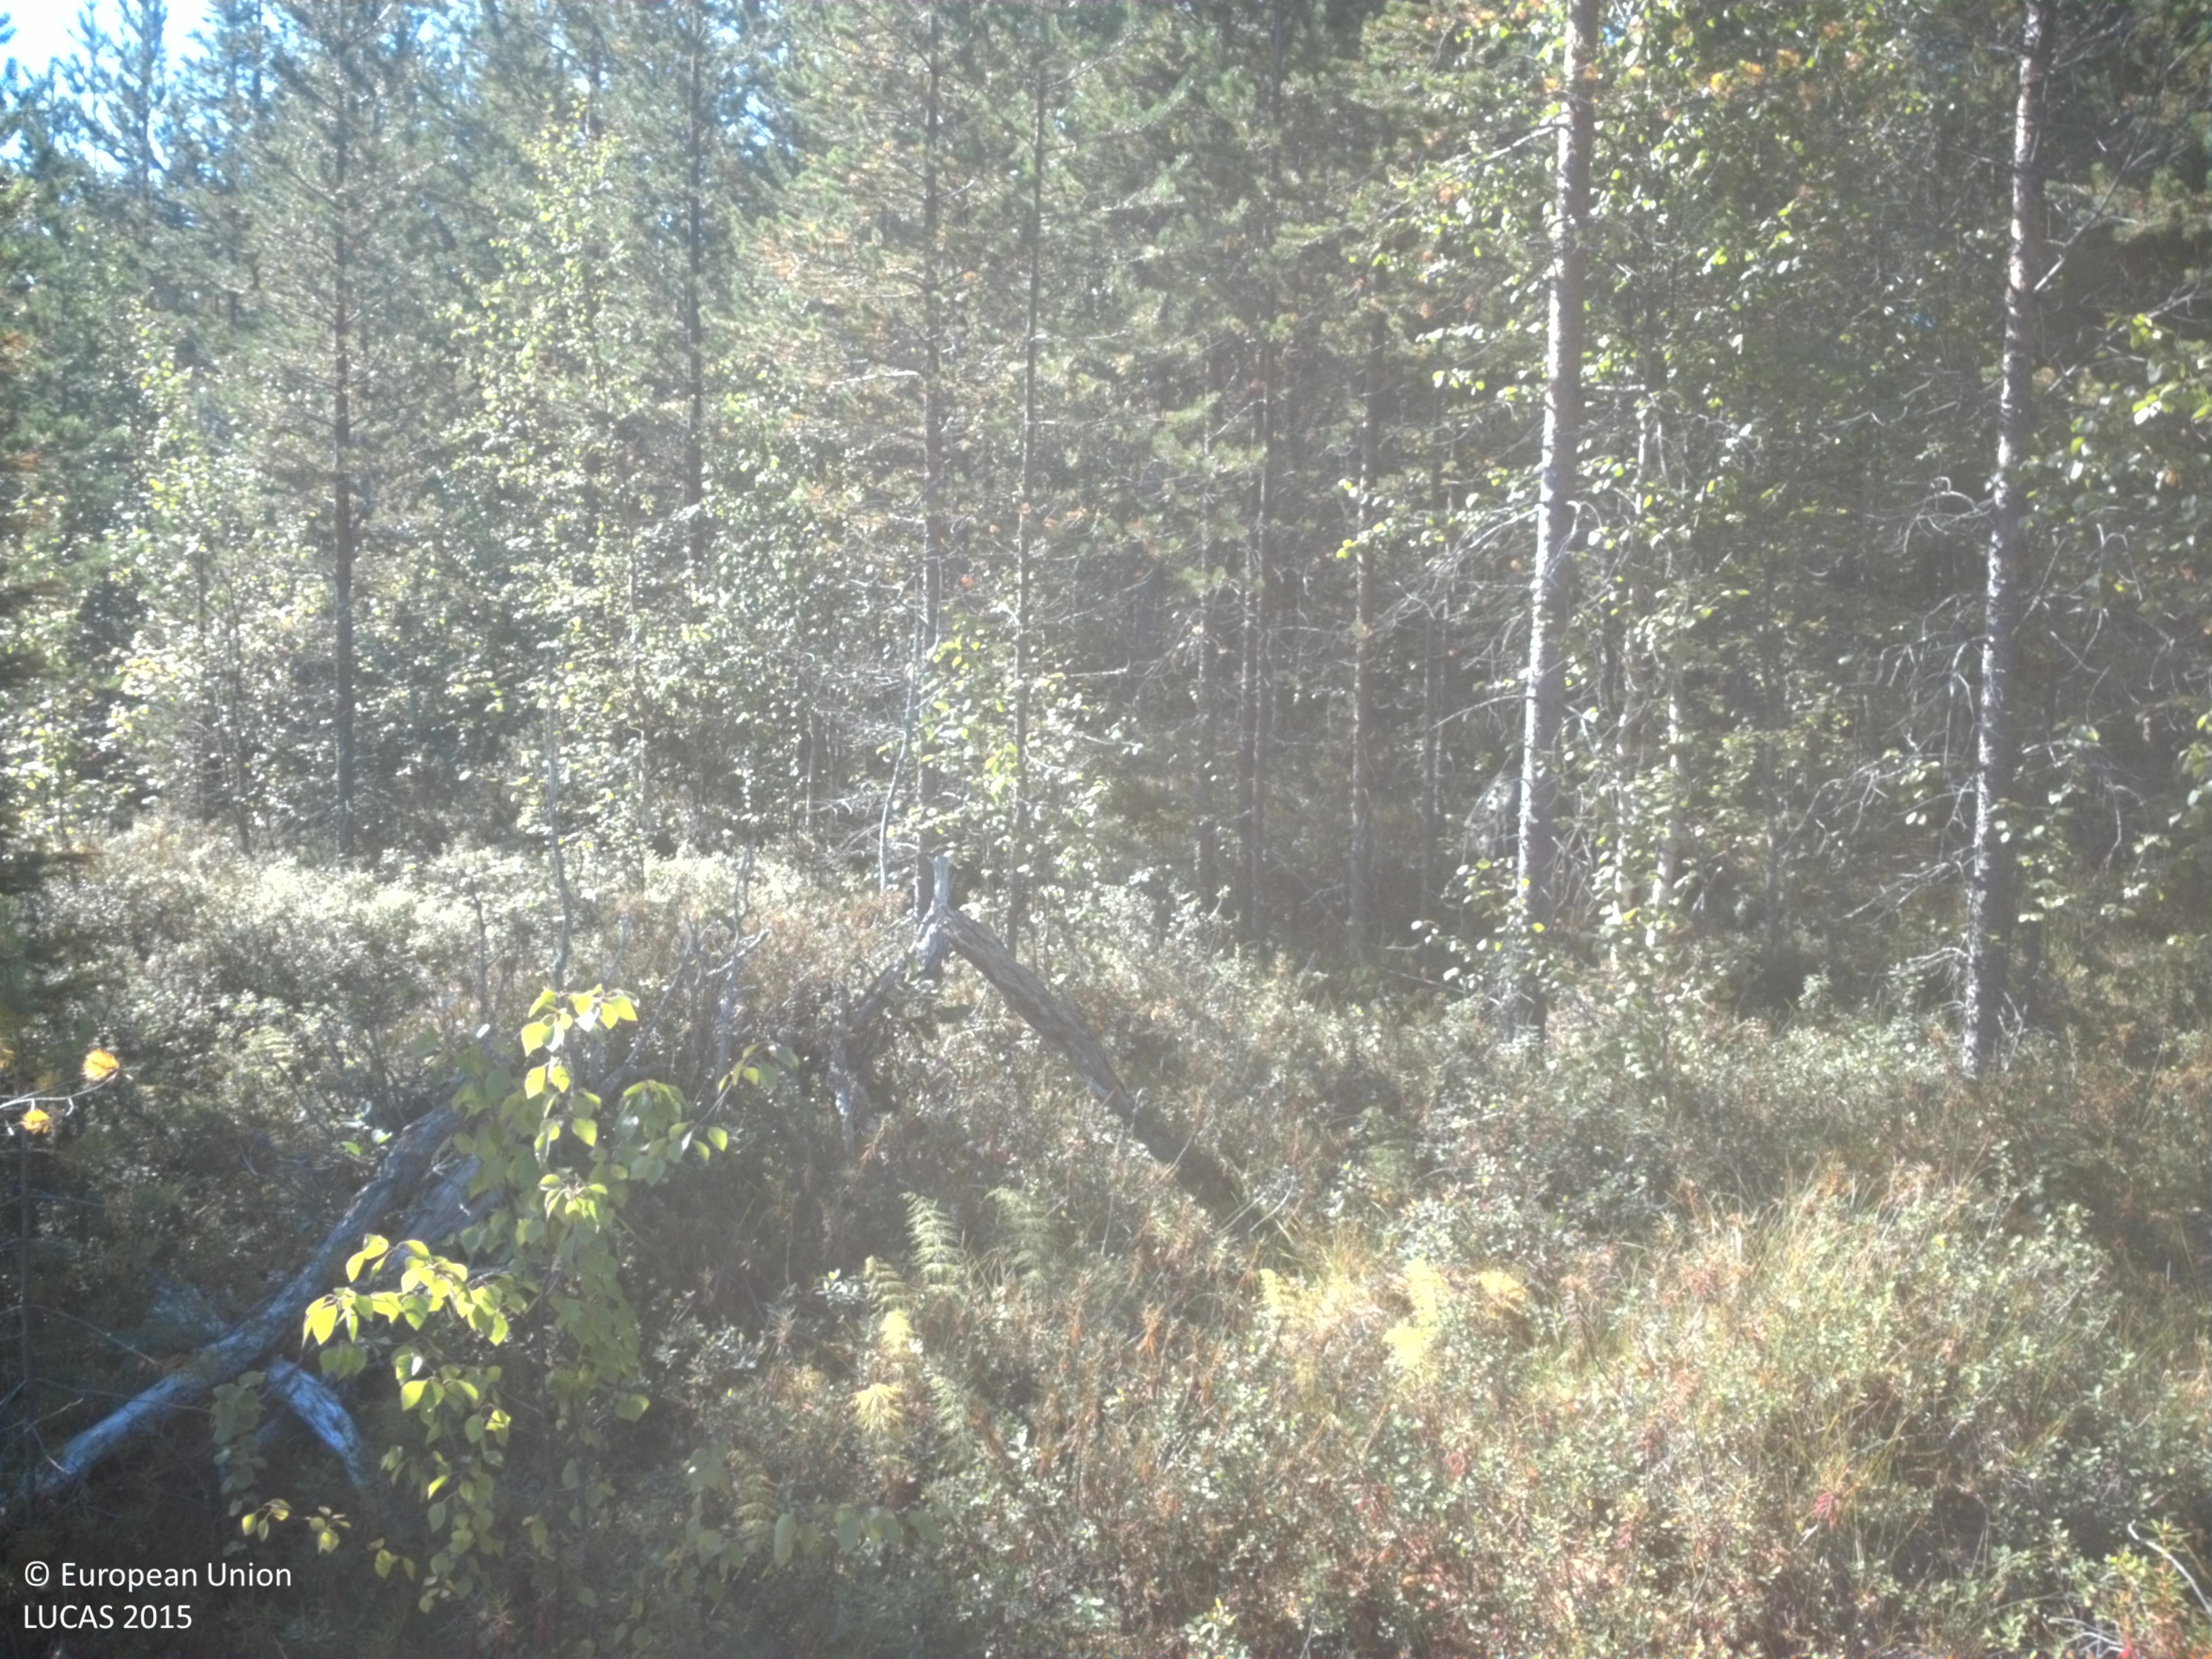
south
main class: Woodland
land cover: Pine dominated mixed woodland
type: boreal forest
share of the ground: 50 - 75 %
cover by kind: coniferous forest trees 45 %, shrubs 20 %, lichens and mosses 20 %, broadleaved forest trees 15 %
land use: Forestry
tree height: > 5 m
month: August
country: SE
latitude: 64.7152
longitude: 18.8435
